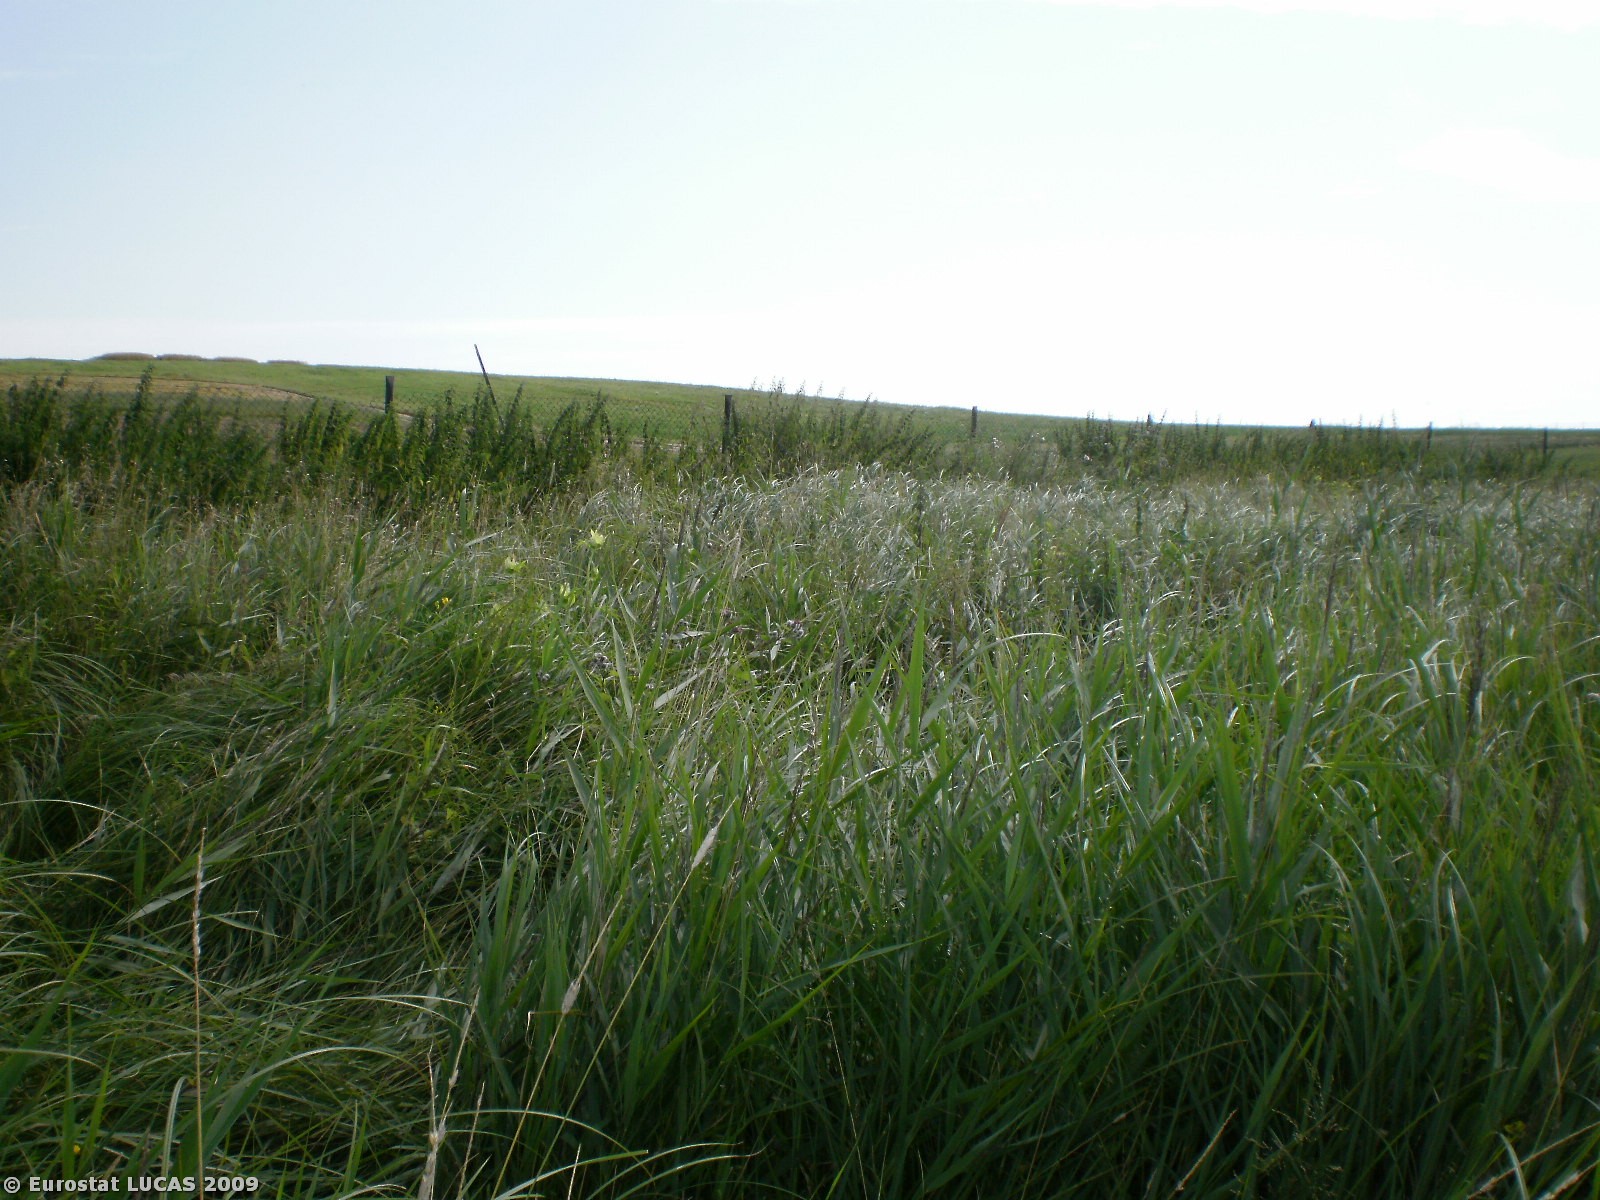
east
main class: Grassland
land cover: Grassland without tree/shrub cover
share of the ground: > 75 %
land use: Agriculture (excluding fallow land and kitchen gardens)
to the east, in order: Grassland without tree/shrub cover; Fences; Grassland without tree/shrub cover; Tracks; Grassland without tree/shrub cover
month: July
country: PL
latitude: 53.7080
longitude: 20.4749
